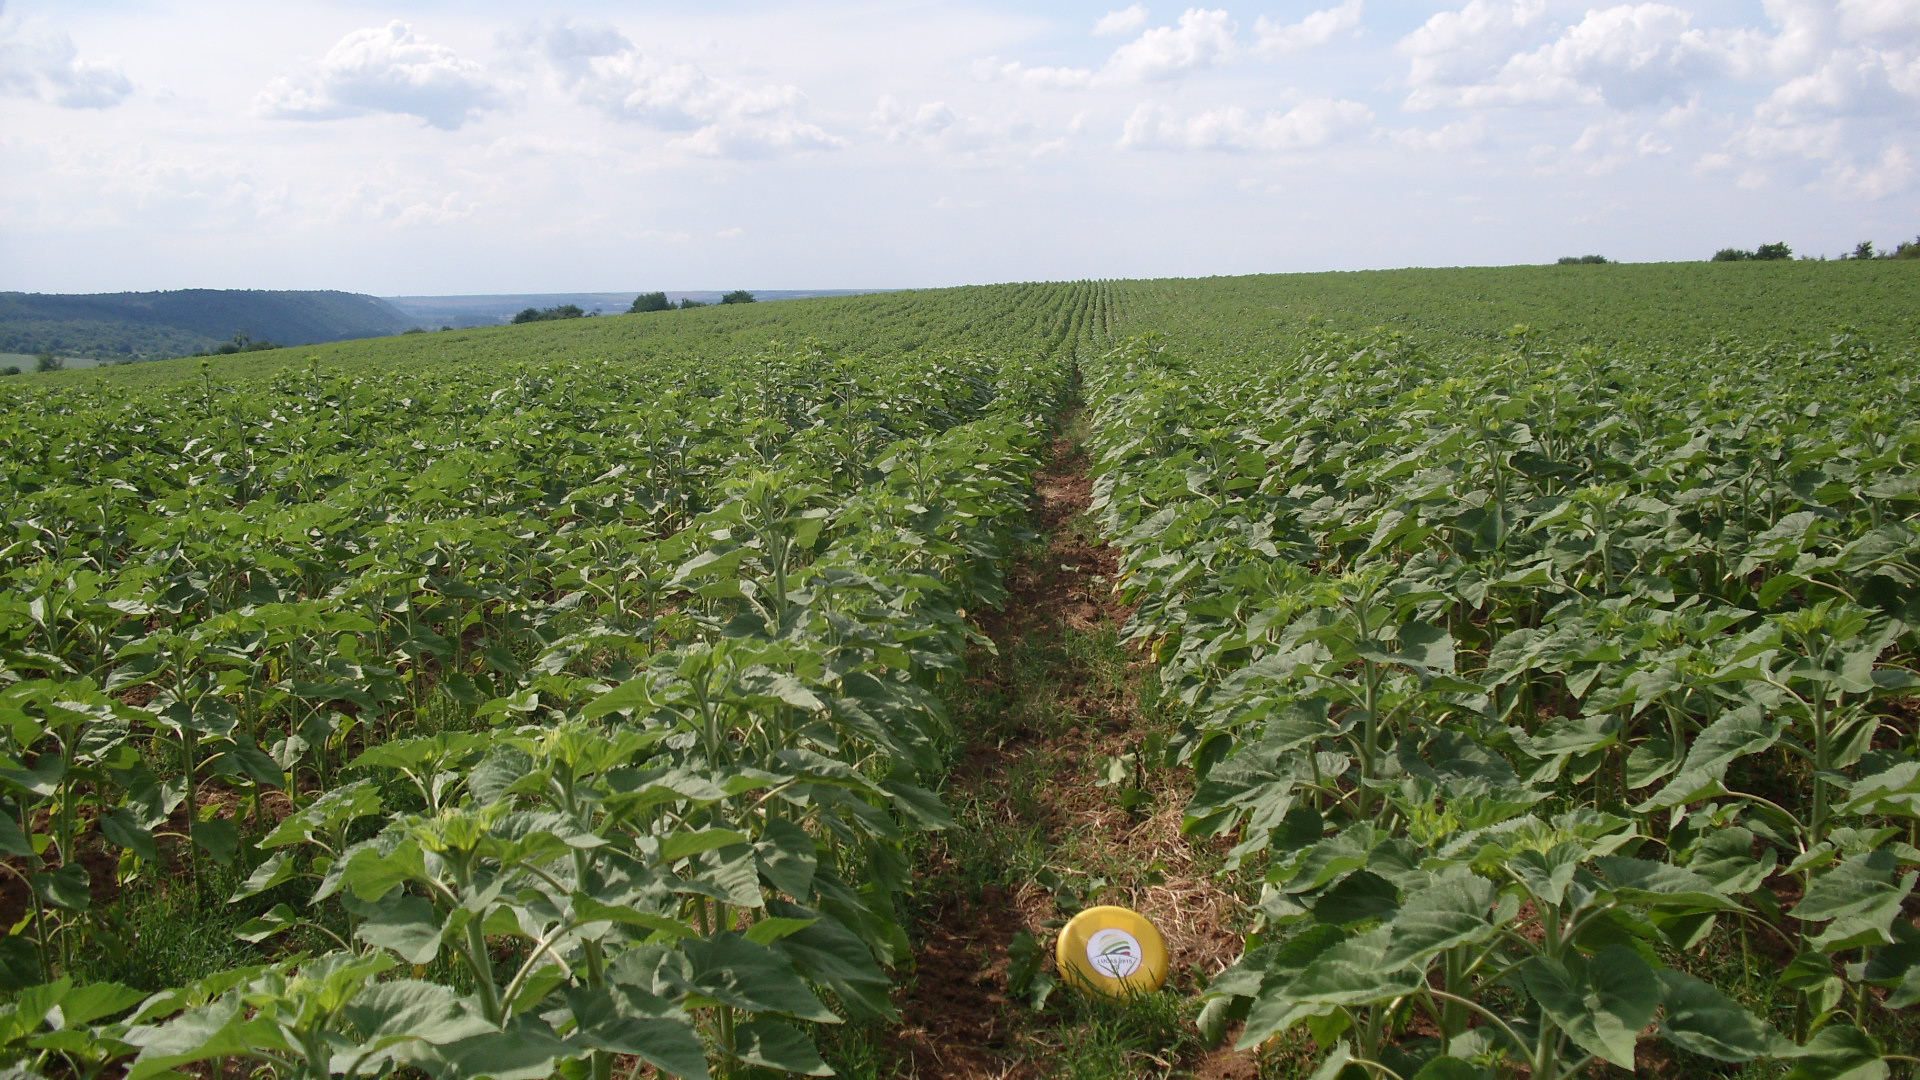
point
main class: Cropland
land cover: Sunflower
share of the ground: 50 - 75 %
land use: Agriculture (excluding fallow land and kitchen gardens)
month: June
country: BG
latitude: 43.4986
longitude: 23.5127
